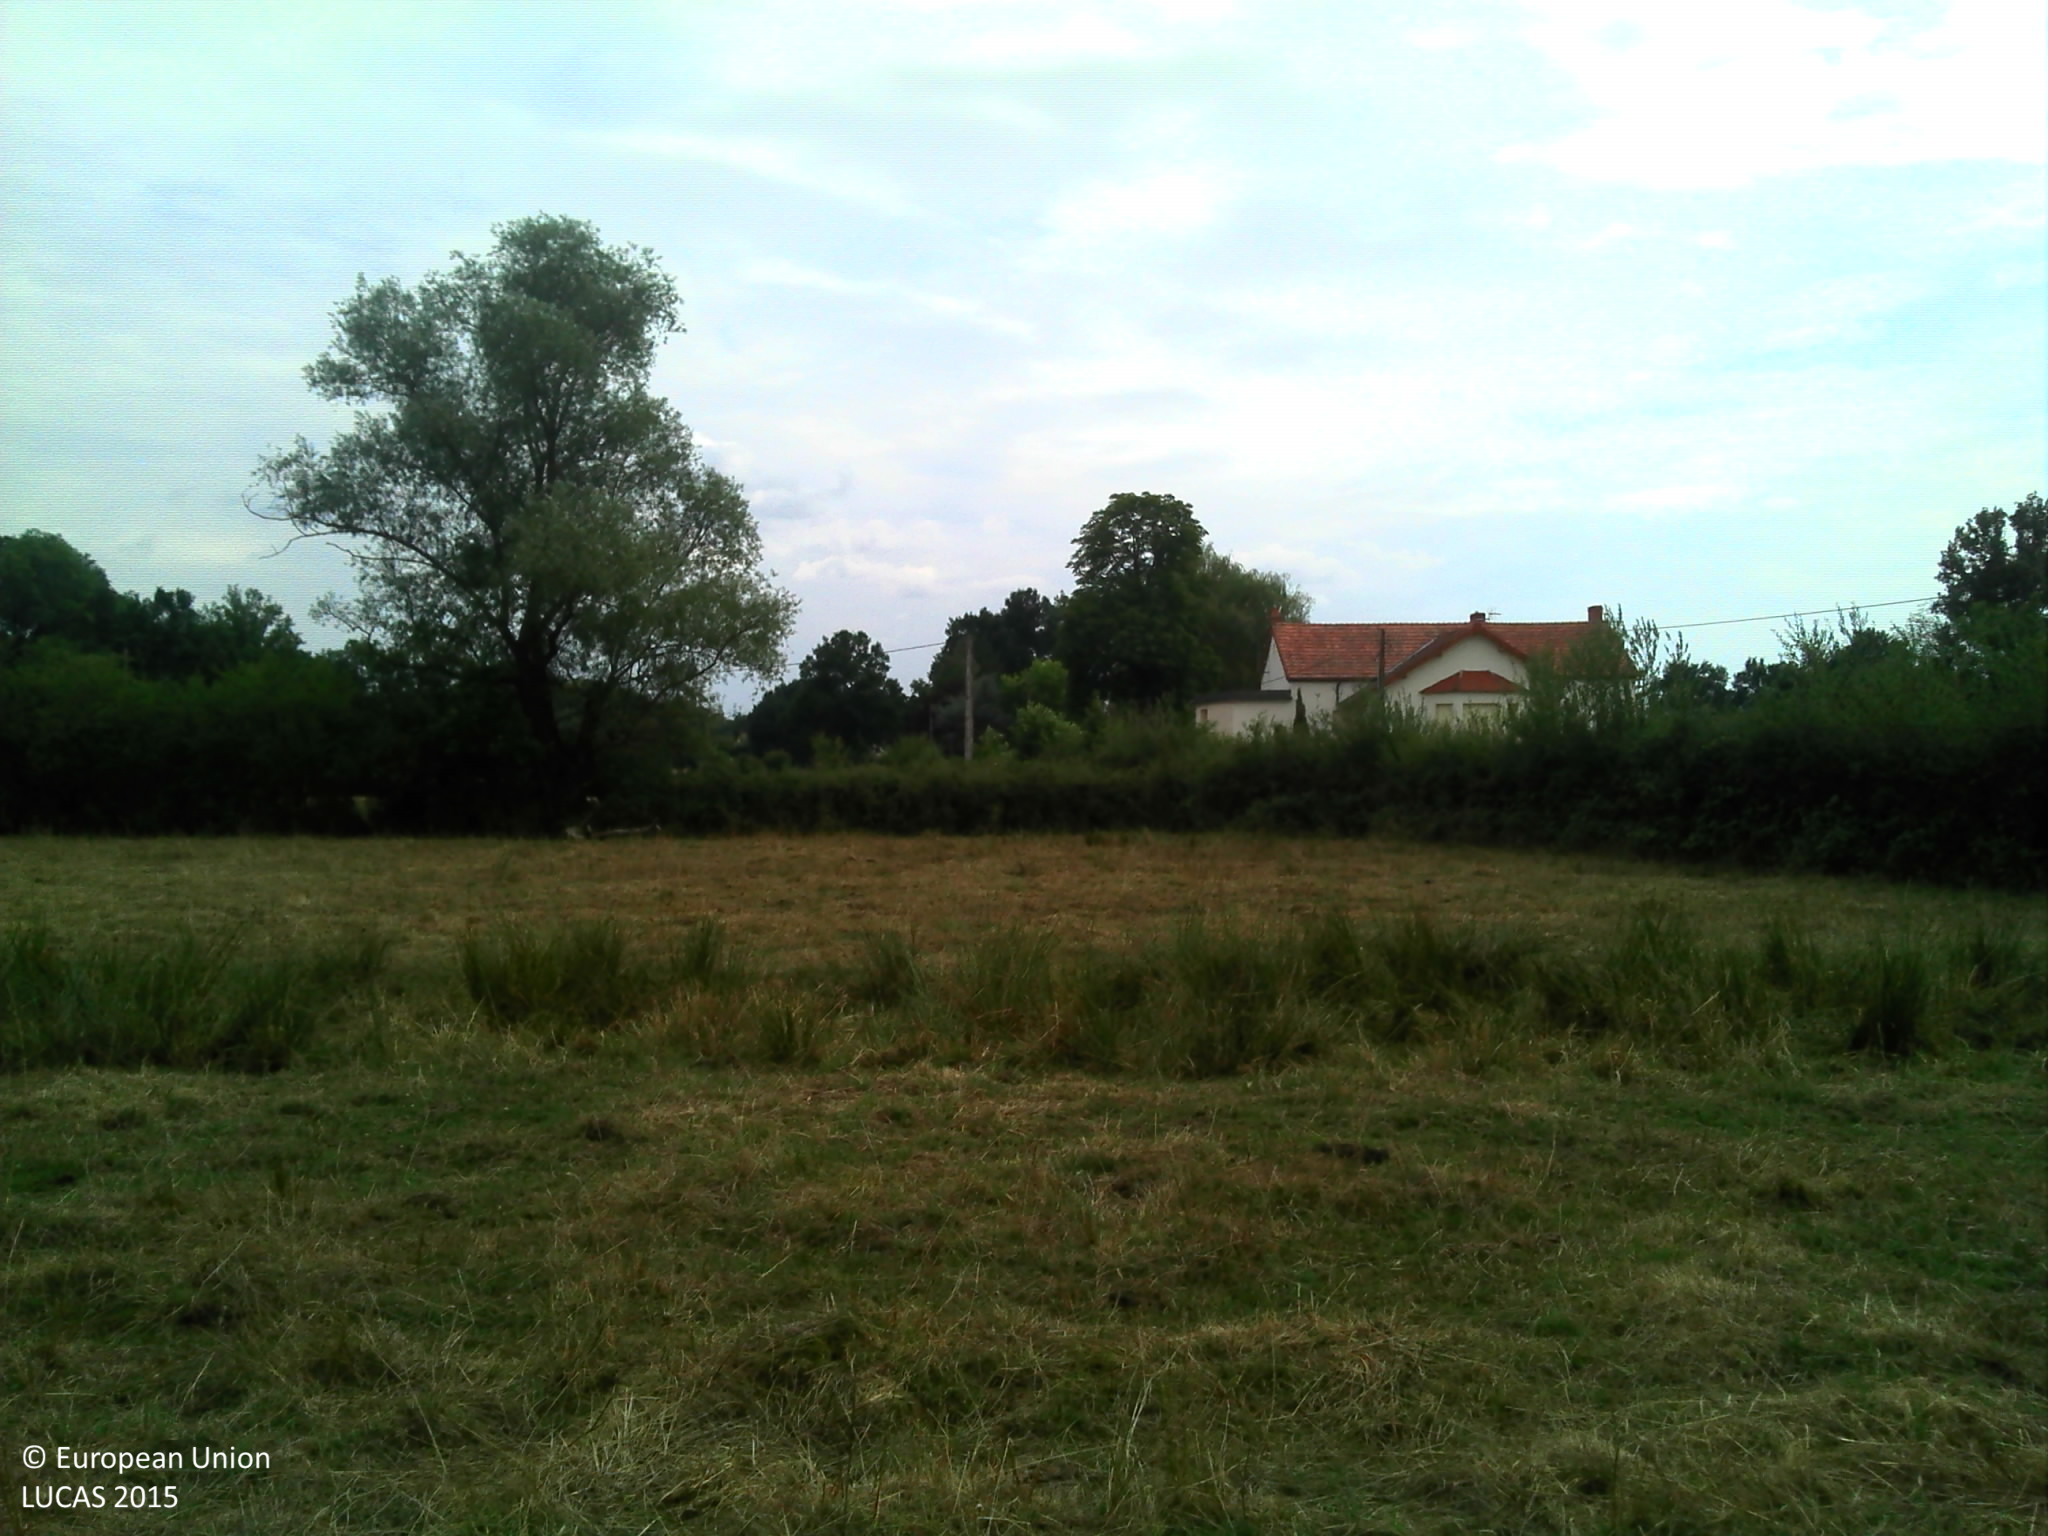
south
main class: Grassland
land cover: Grassland without tree/shrub cover
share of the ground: > 75 %
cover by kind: herbaceous plants 100 %
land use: Agriculture (excluding fallow land and kitchen gardens)
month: August
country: FR
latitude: 46.2696
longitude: 3.6289
